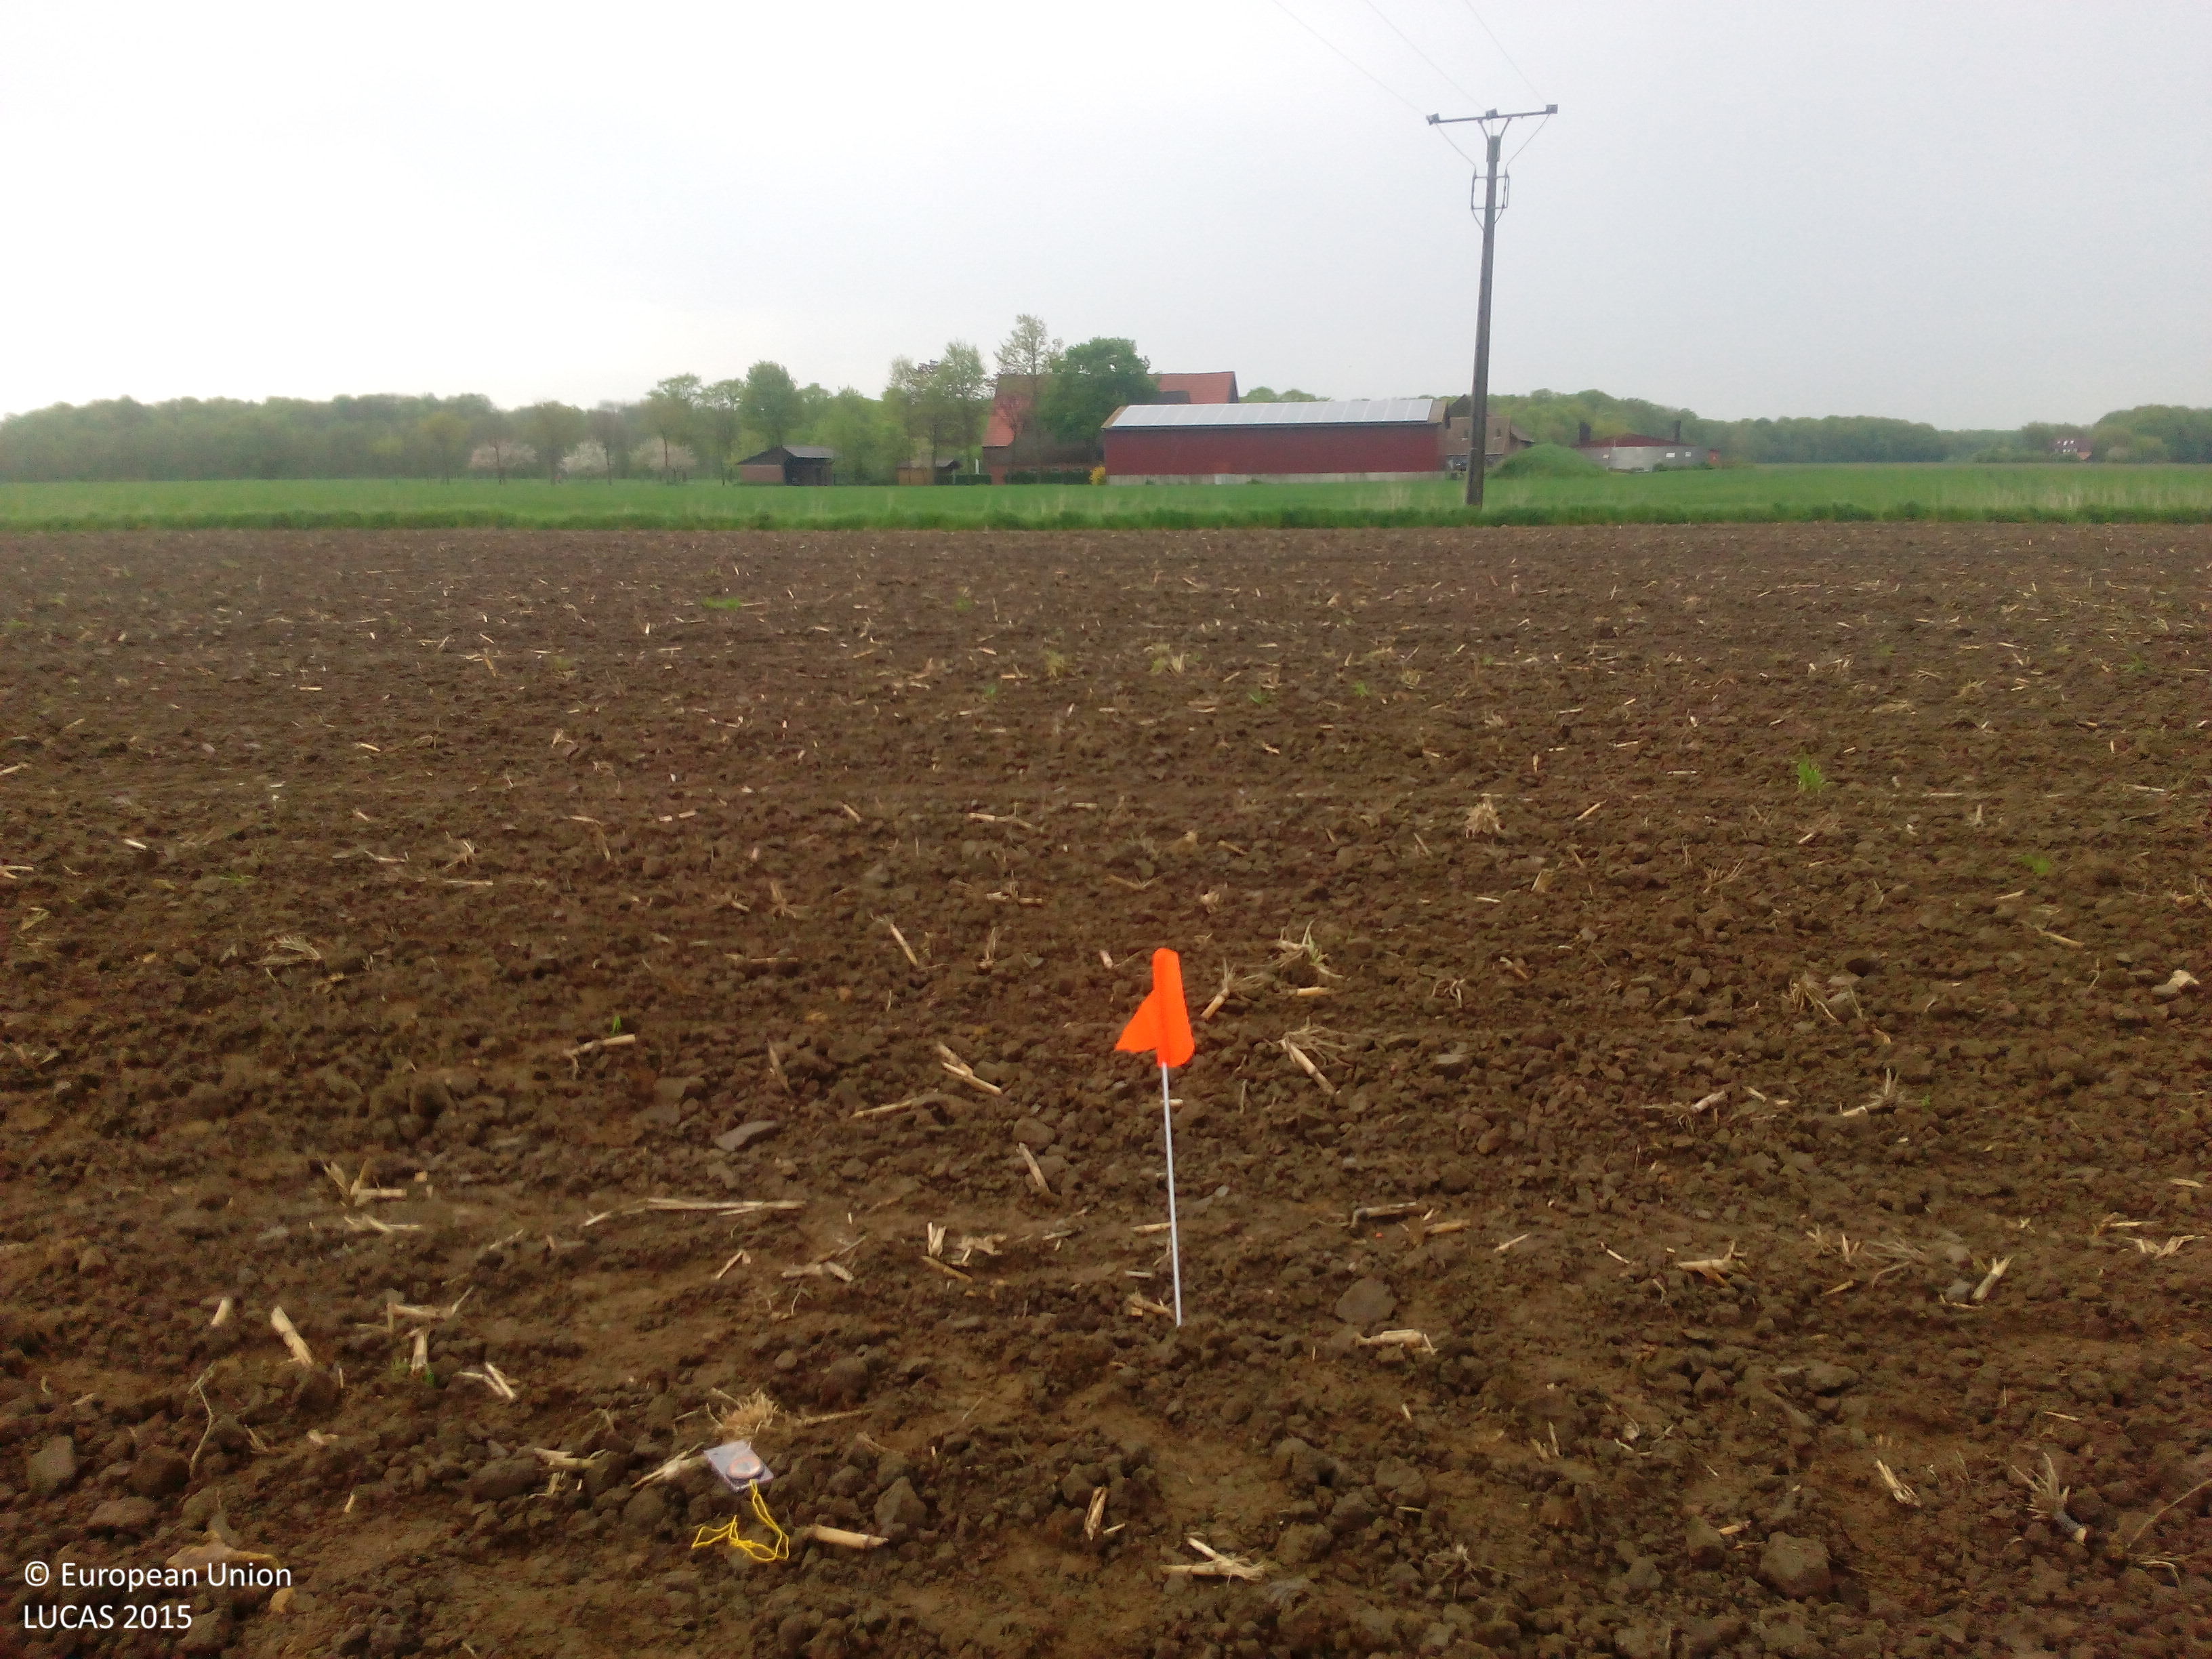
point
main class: Cropland
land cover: Maize
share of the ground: < 10 %
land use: Agriculture (excluding fallow land and kitchen gardens)
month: May
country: DE
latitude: 51.8648
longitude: 7.4589
